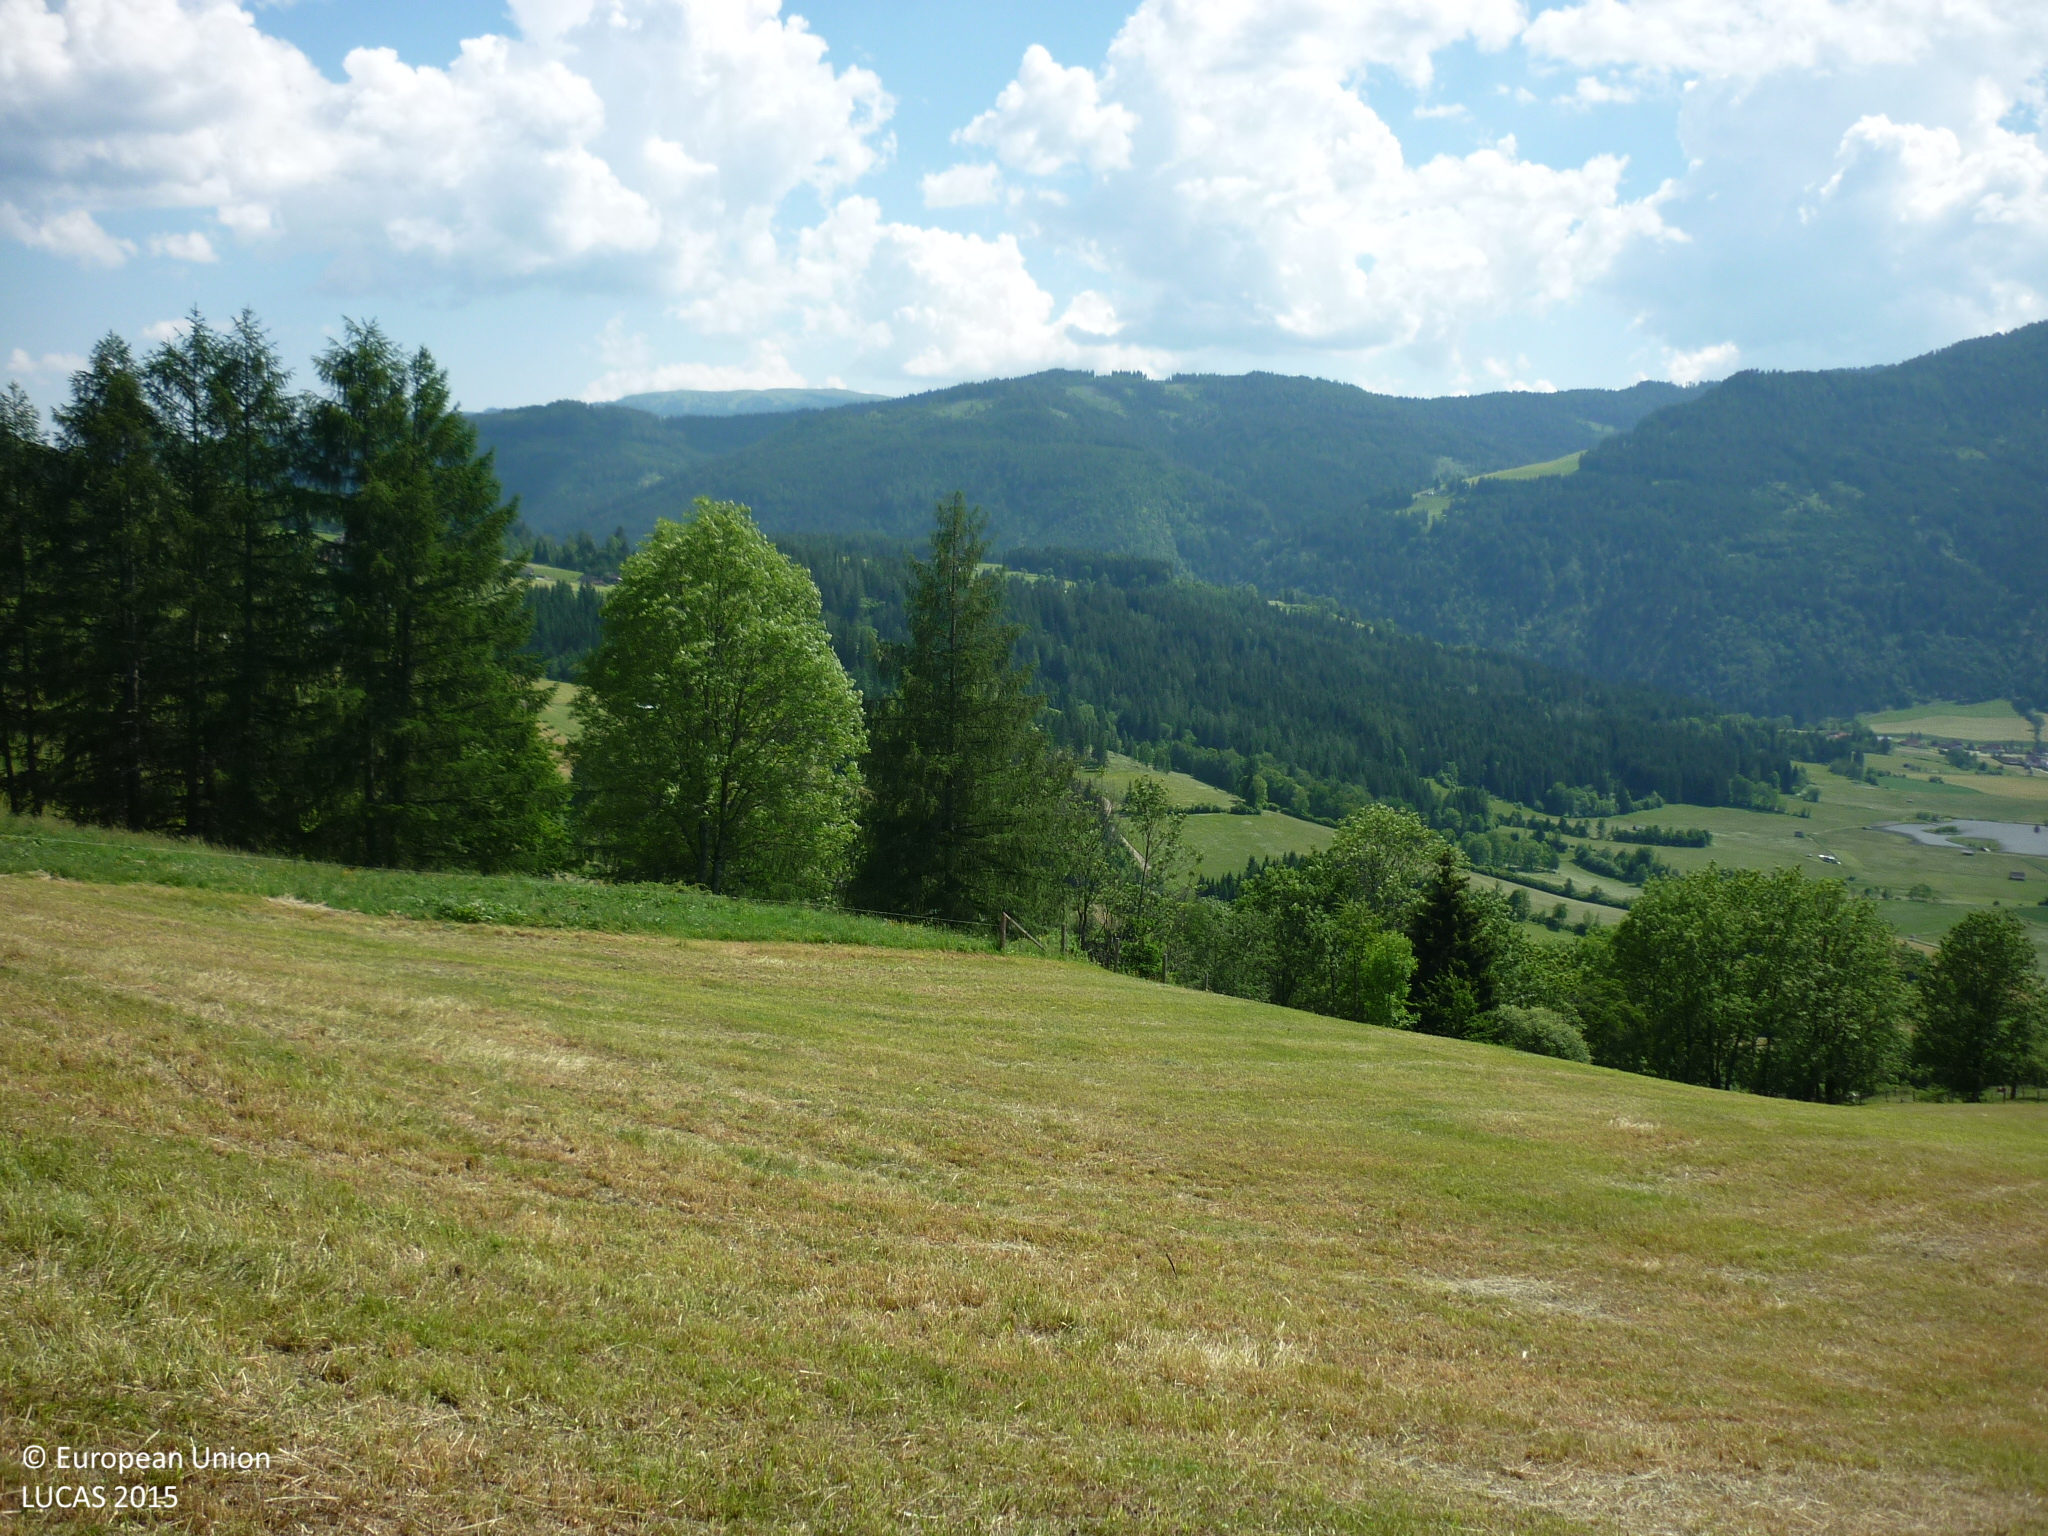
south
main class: Grassland
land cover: Grassland without tree/shrub cover
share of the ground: > 75 %
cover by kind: herbaceous plants 100 %
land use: Agriculture (excluding fallow land and kitchen gardens)
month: June
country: AT
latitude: 47.1731
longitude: 14.1279
